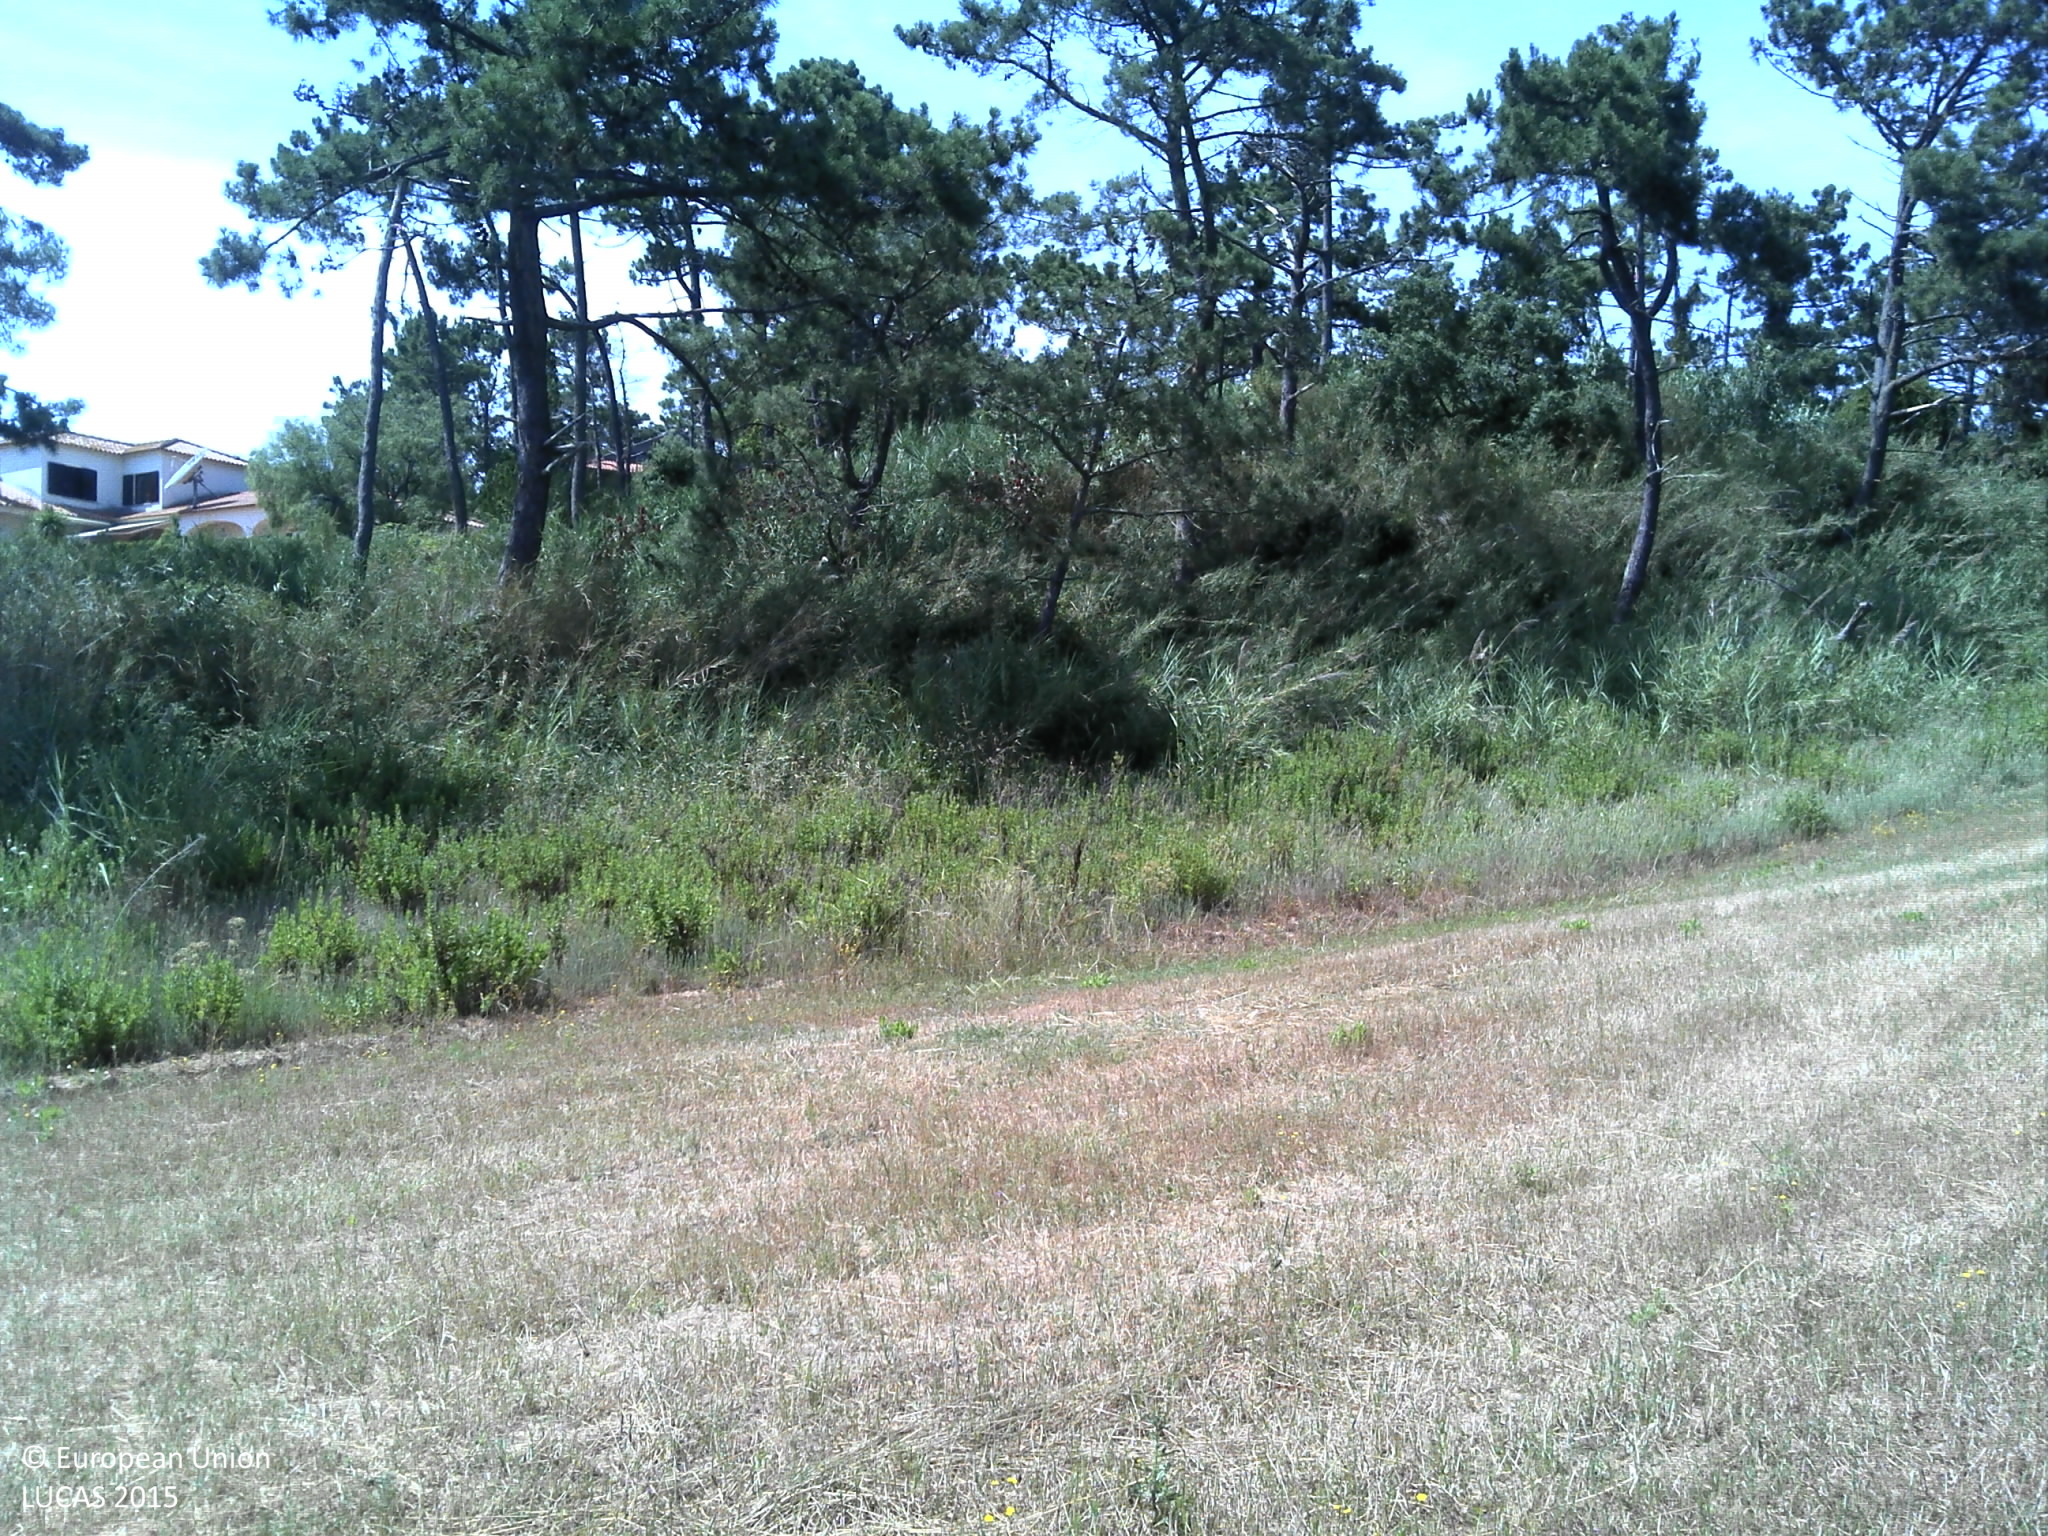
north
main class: Grassland
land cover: Grassland without tree/shrub cover
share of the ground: 50 - 75 %
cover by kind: herbaceous plants 70 %, unconsolidated bare surface 25 %, shrubs 5 %
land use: Agriculture (excluding fallow land and kitchen gardens)
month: June
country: PT
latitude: 39.2540
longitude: -9.3162
